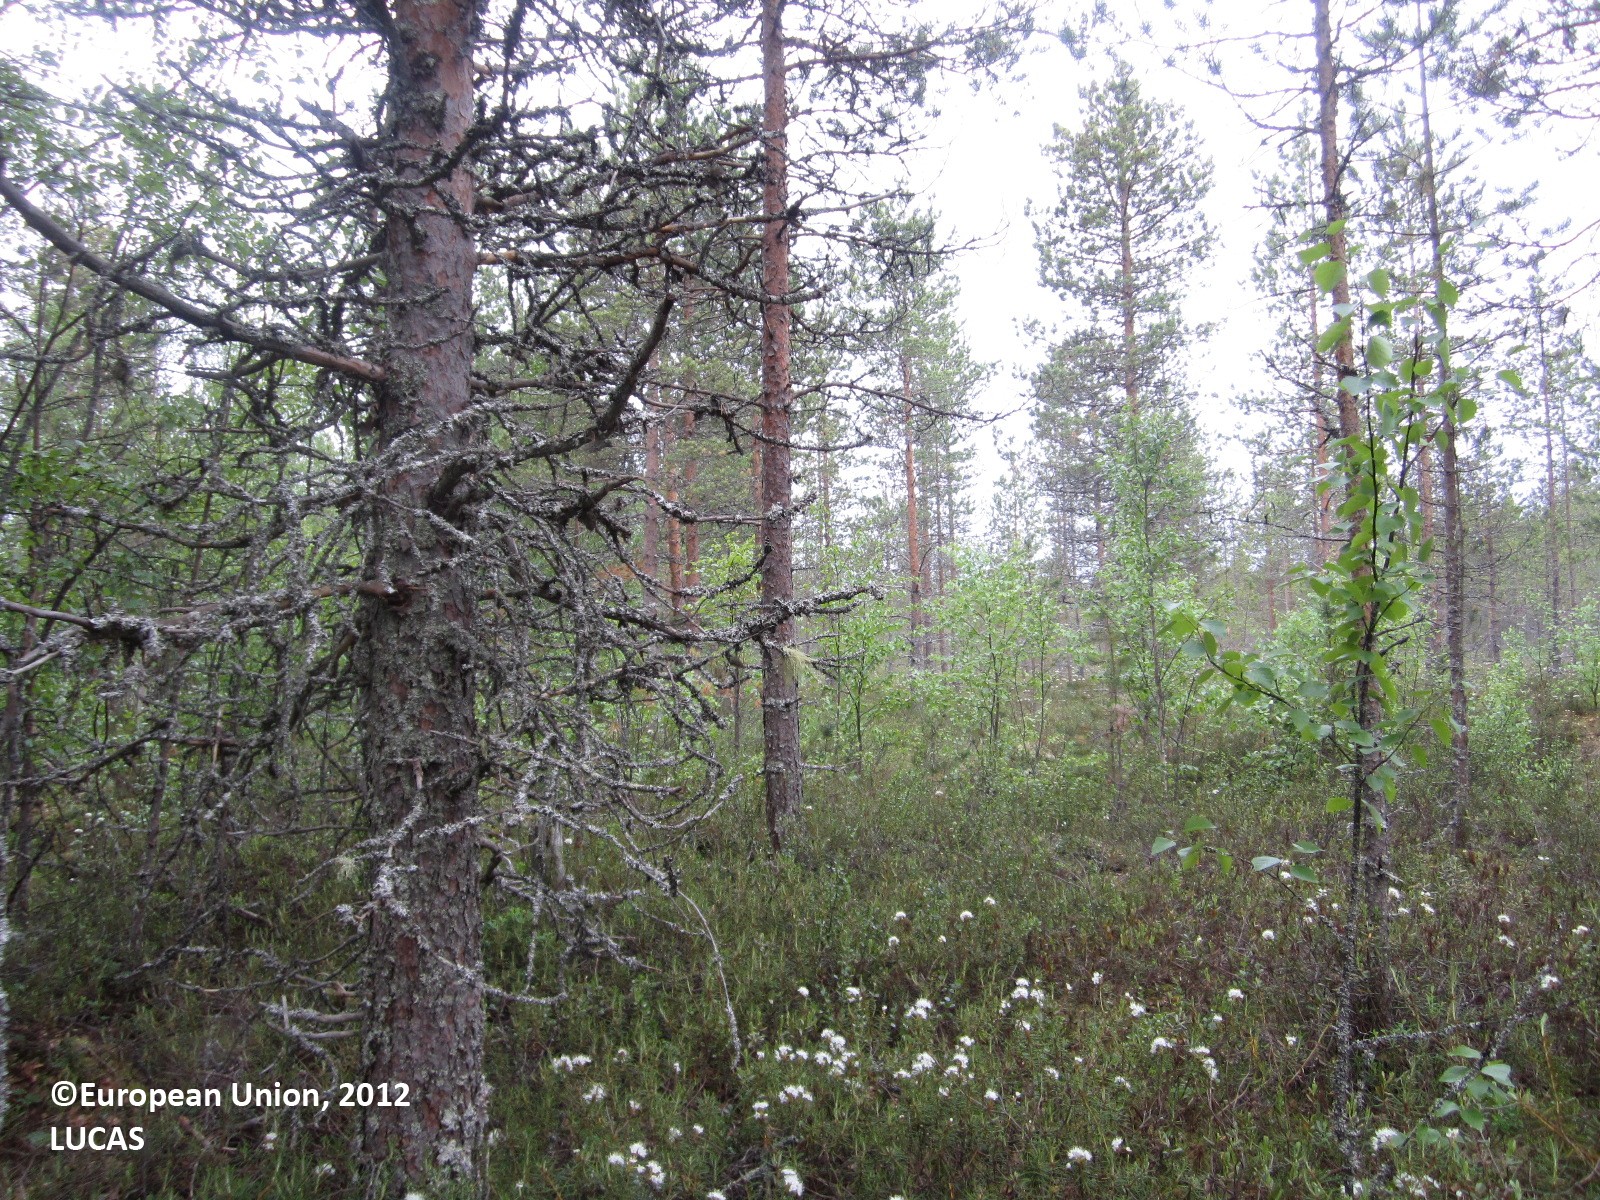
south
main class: Woodland
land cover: Pine dominated coniferous woodland
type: boreal forest
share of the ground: 50 - 75 %
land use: Forestry
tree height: > 5 m
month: June
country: FI
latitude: 64.4358
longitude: 29.5532
